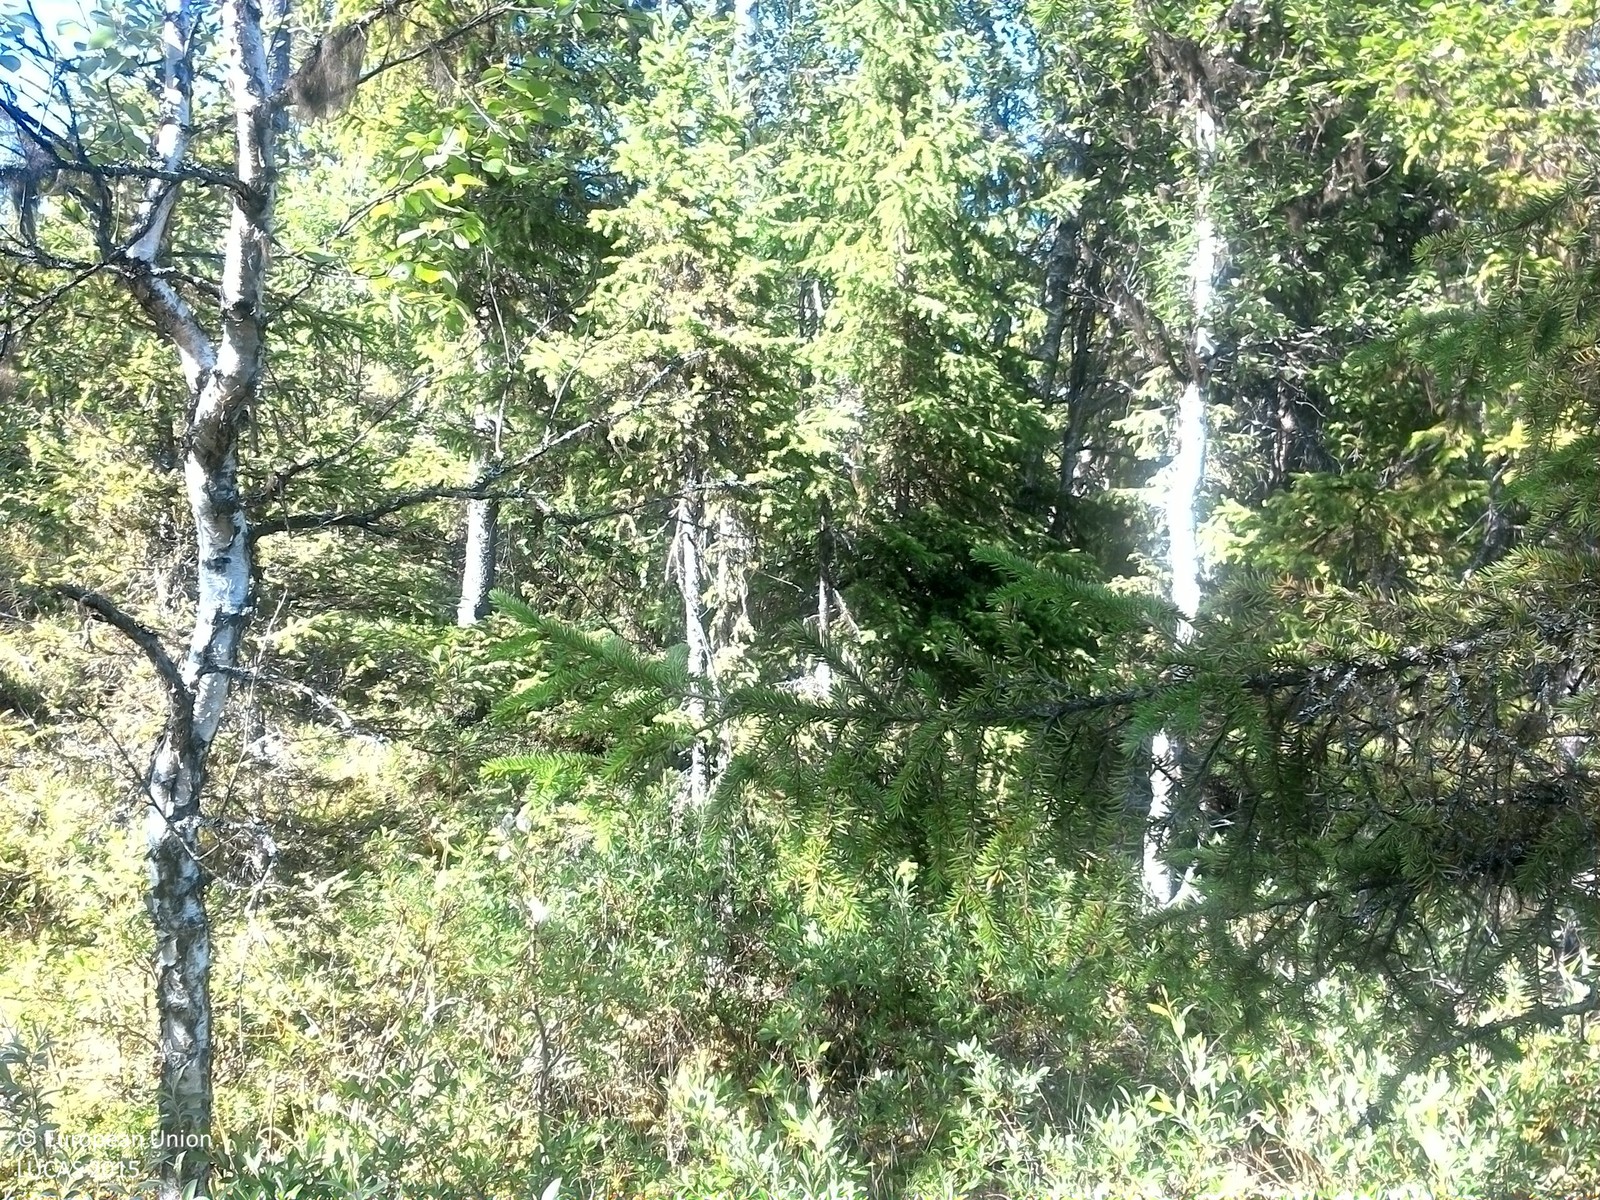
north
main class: Woodland
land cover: Spruce dominated coniferous woodland
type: mire and swamp forests
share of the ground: 25 - 50 %
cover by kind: coniferous forest trees 40 %, shrubs 25 %, lichens and mosses 25 %, broadleaved forest trees 5 %, herbaceous plants 5 %
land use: Semi-natural and natural areas not in use
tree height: > 5 m
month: July
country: SE
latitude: 64.5656
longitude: 15.7496
